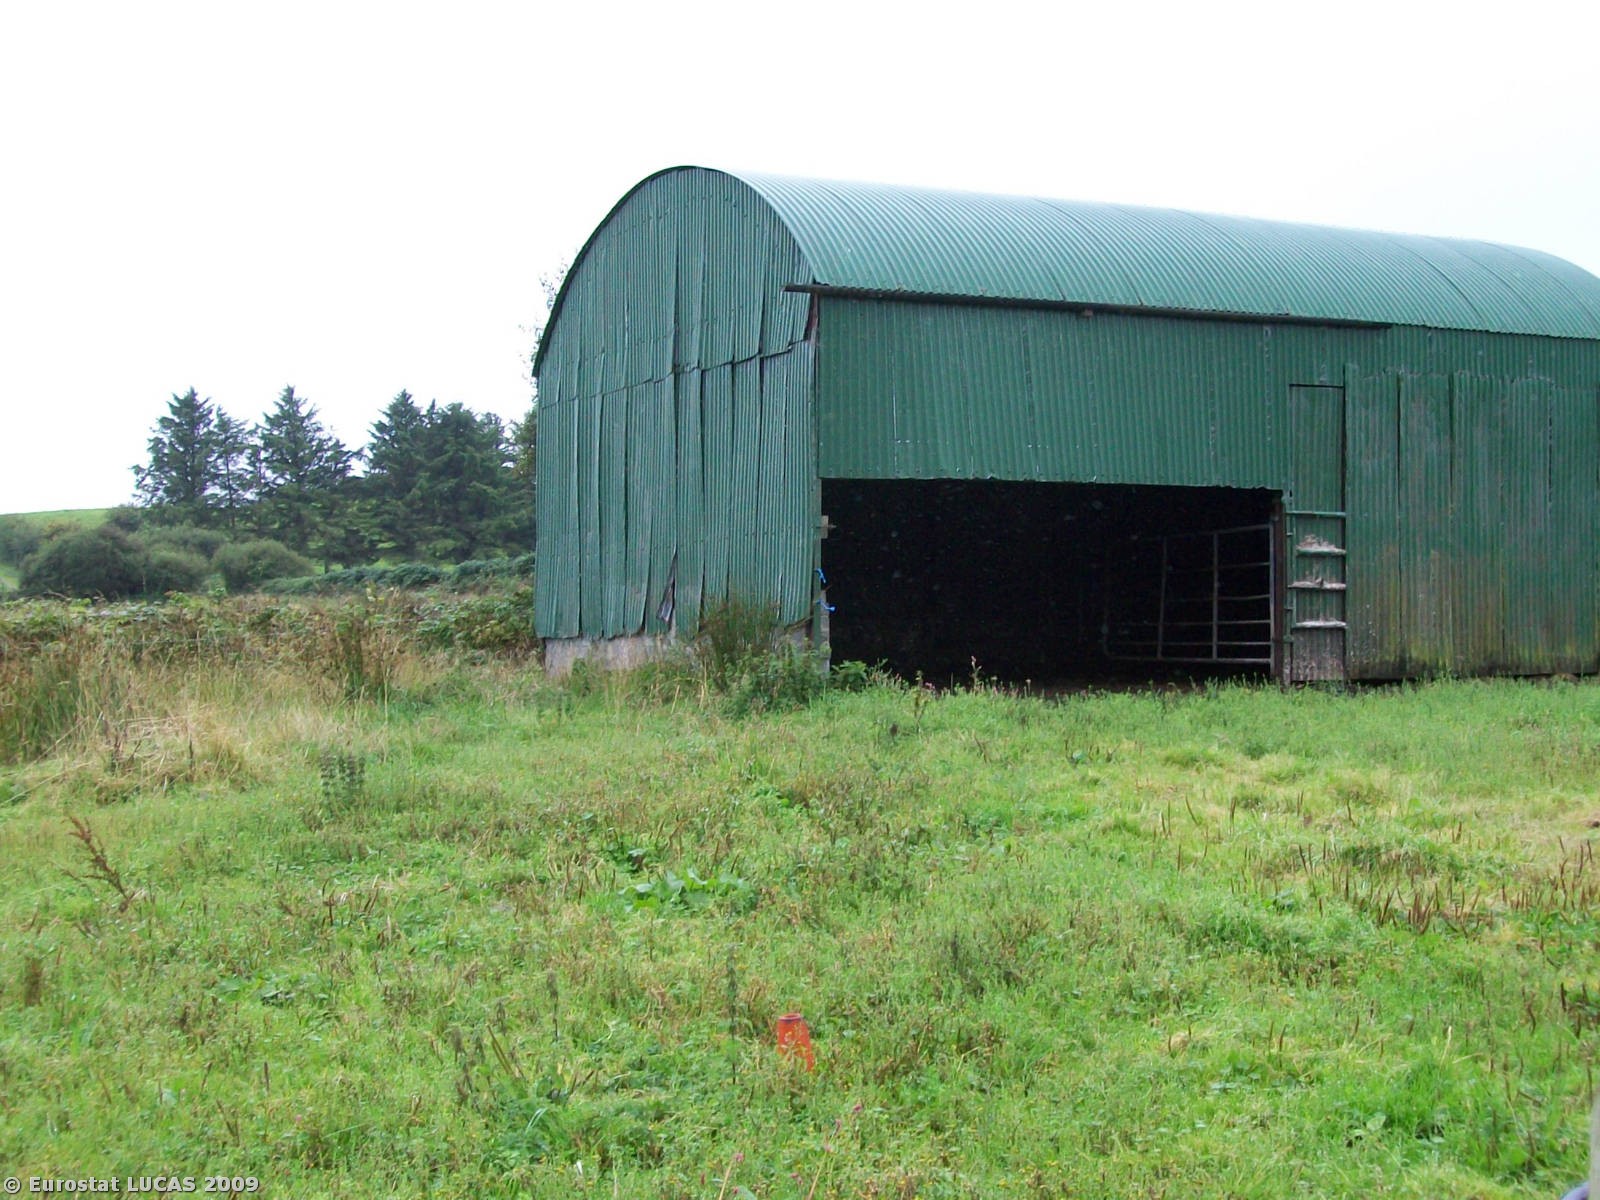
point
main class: Grassland
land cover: Grassland without tree/shrub cover
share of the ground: > 75 %
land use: Agriculture (excluding fallow land and kitchen gardens)
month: August
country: IE
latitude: 52.9106
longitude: -9.2410
